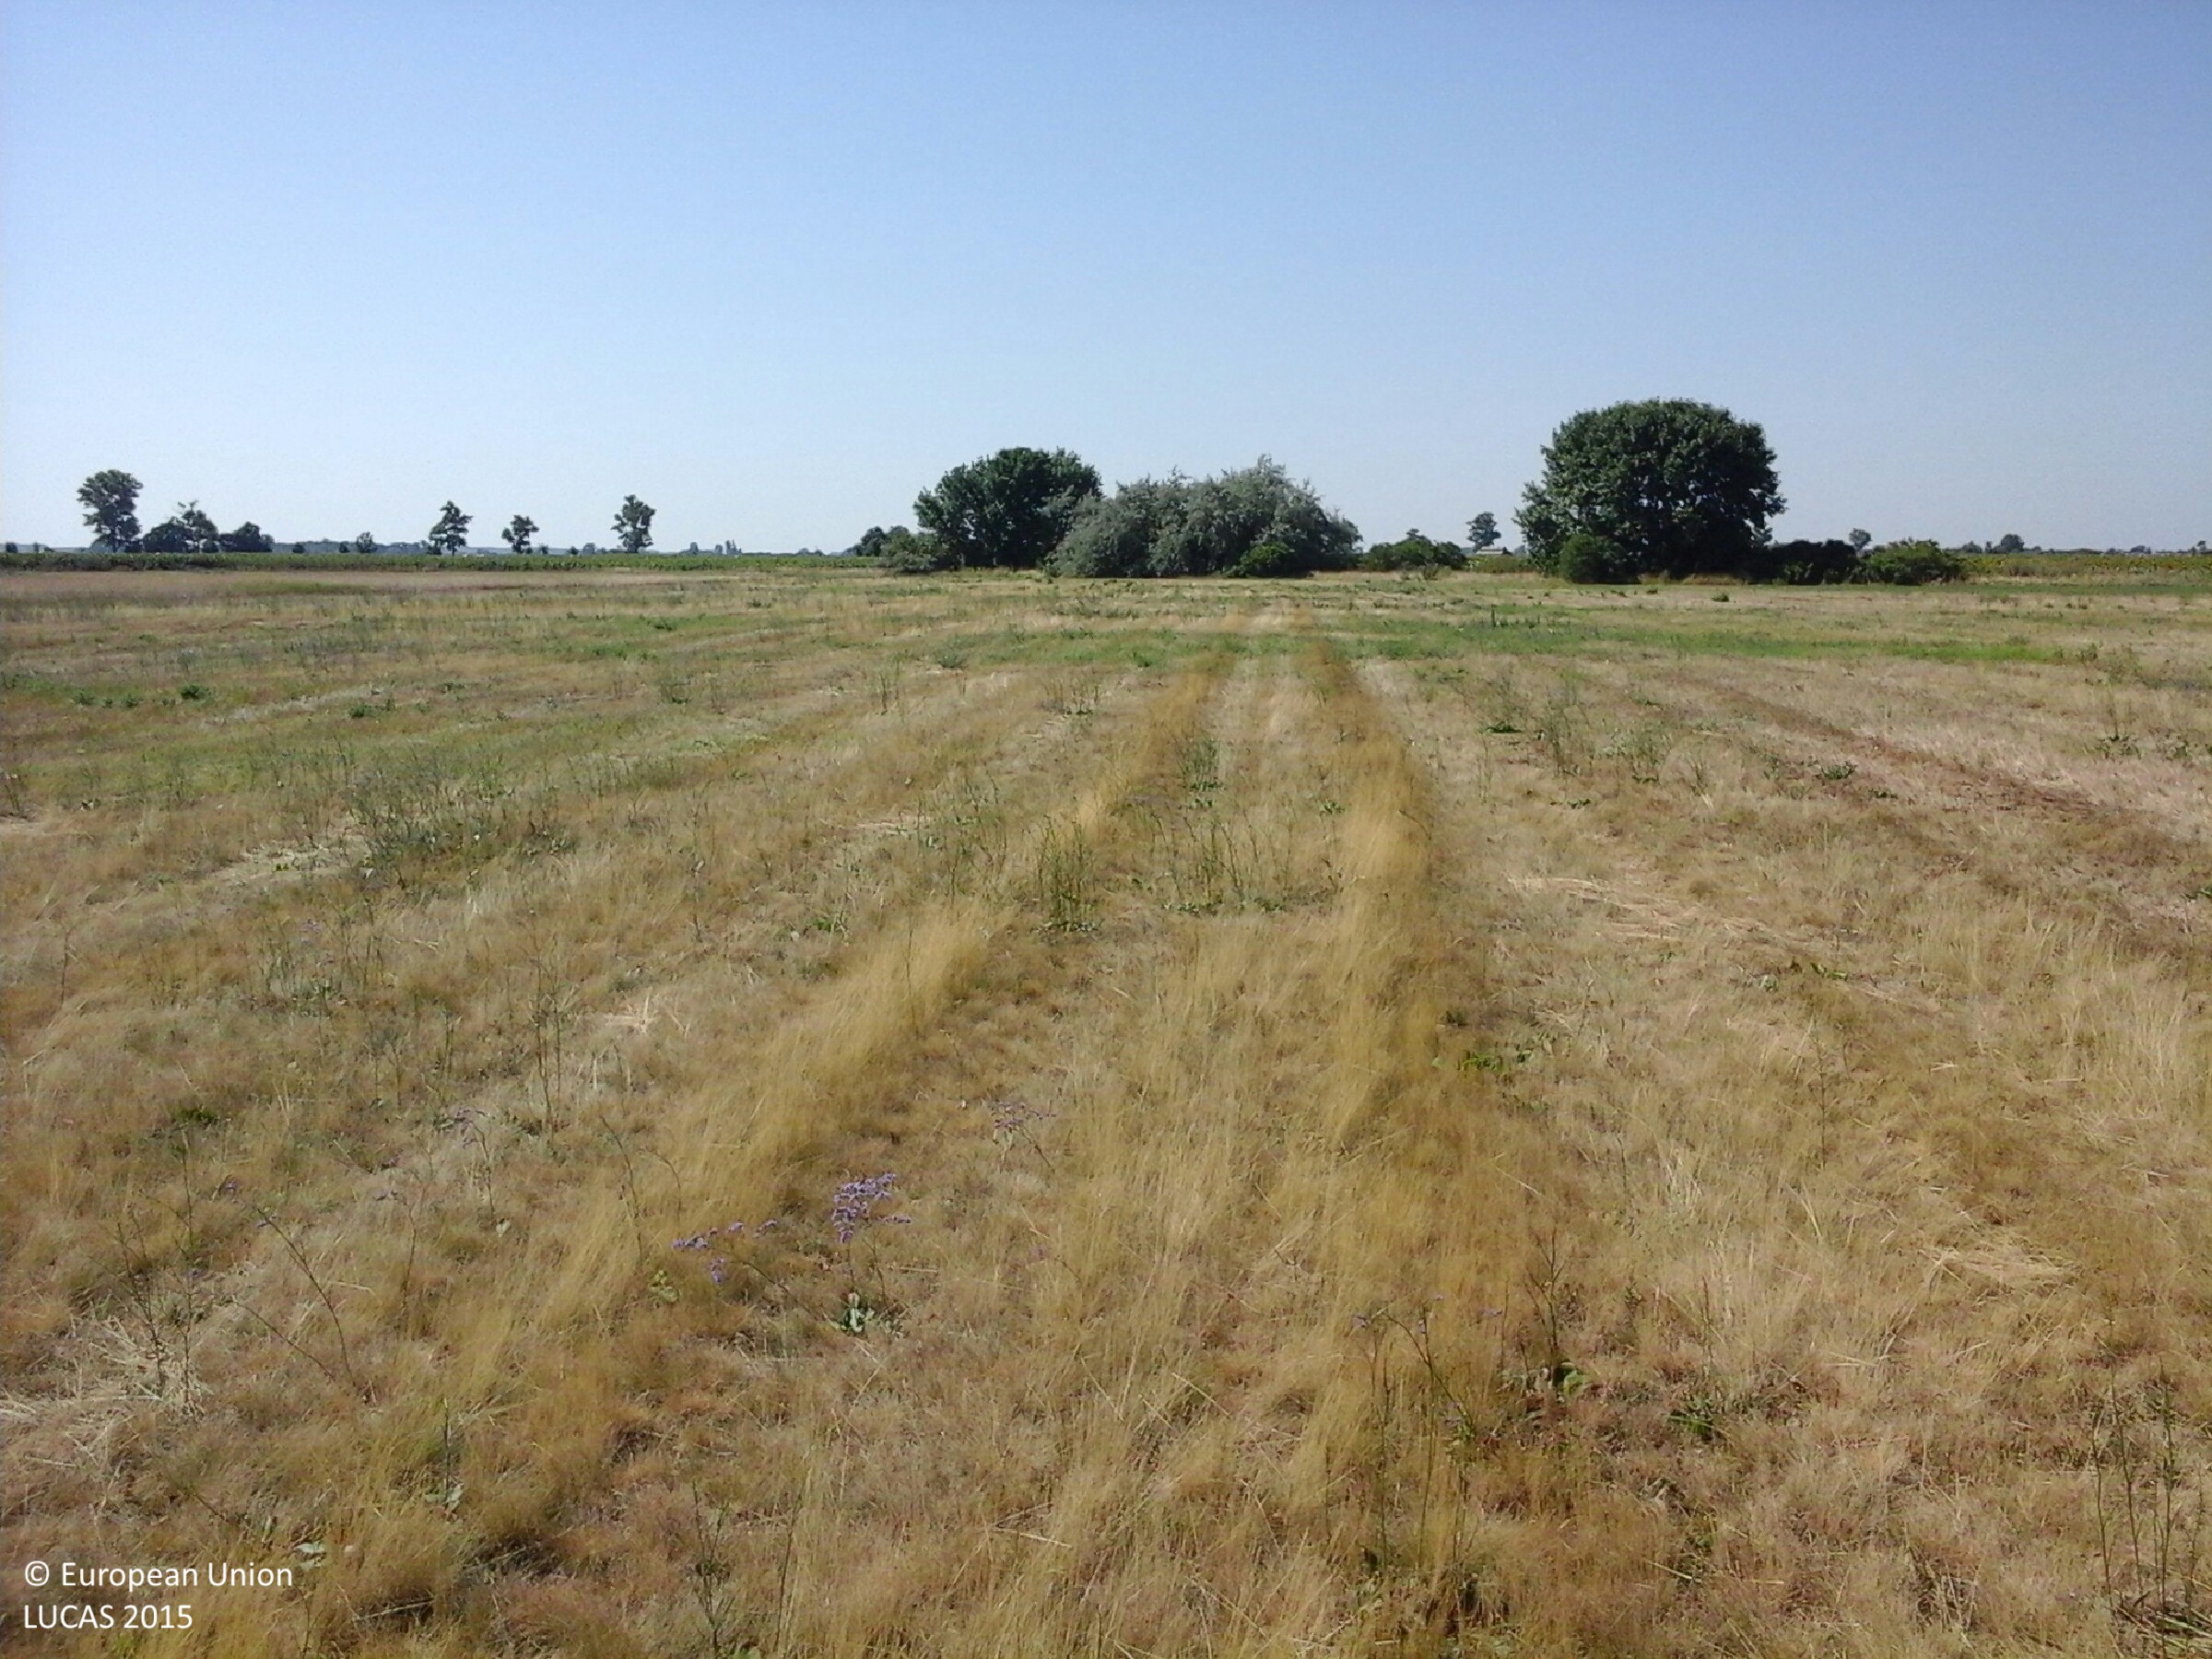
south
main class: Grassland
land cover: Grassland without tree/shrub cover
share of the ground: > 75 %
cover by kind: herbaceous plants 100 %
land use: Agriculture (excluding fallow land and kitchen gardens)
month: July
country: HU
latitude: 47.5888
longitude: 20.5504
